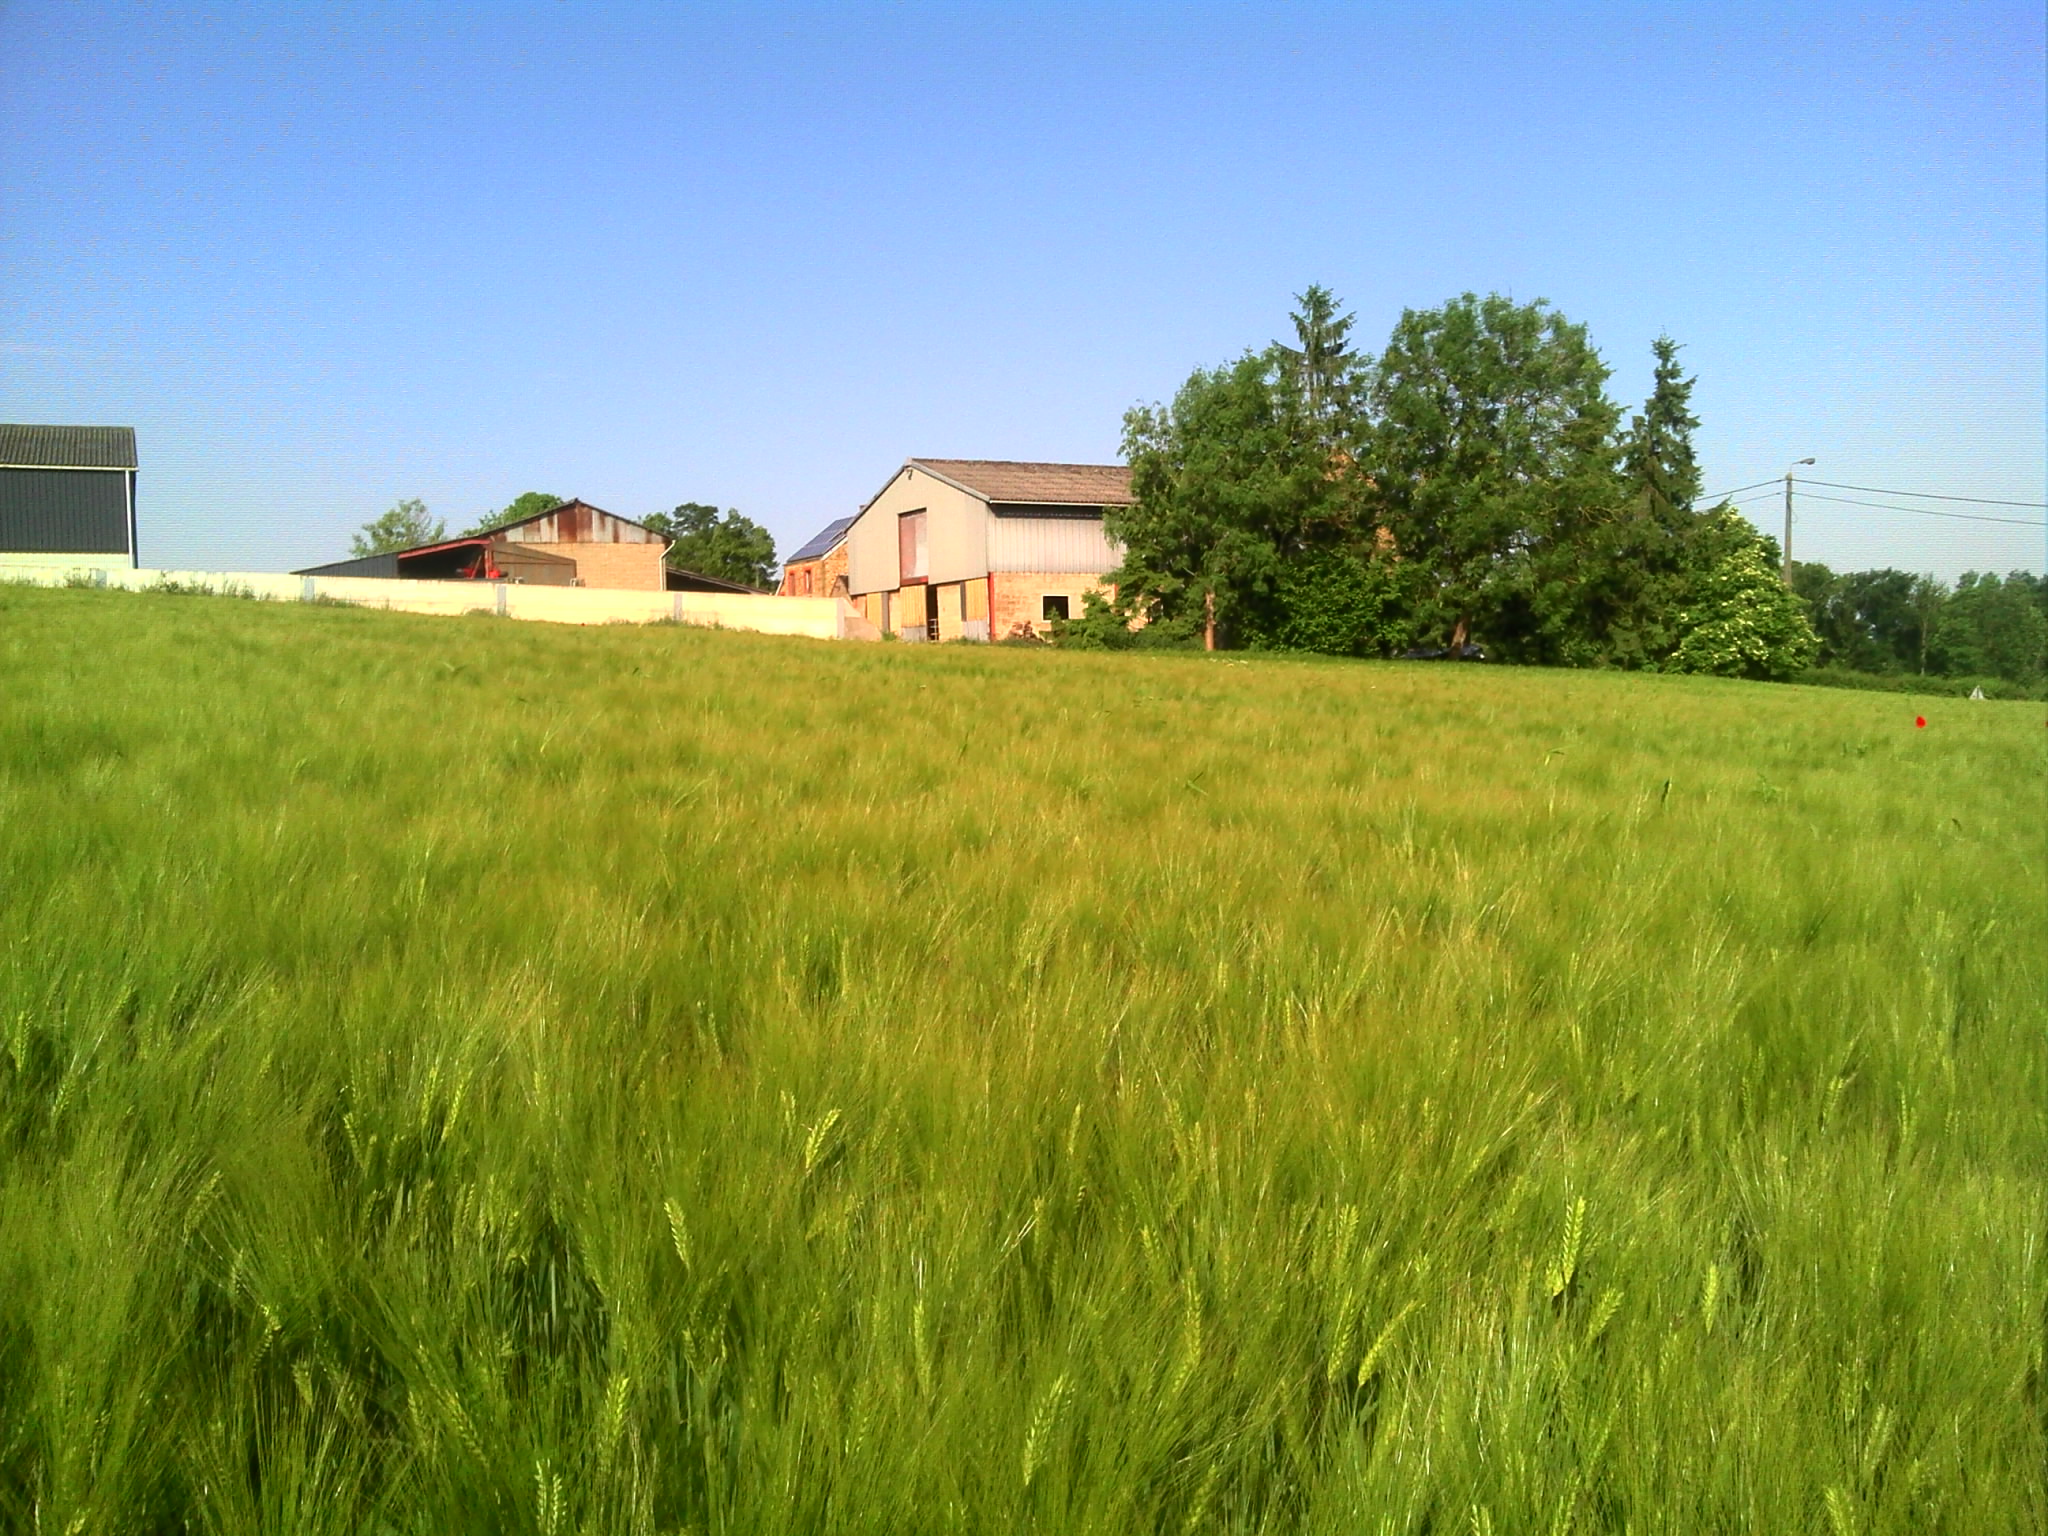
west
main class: Cropland
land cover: Barley
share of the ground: > 75 %
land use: Agriculture (excluding fallow land and kitchen gardens)
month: June
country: BE
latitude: 50.3333
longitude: 5.1507
